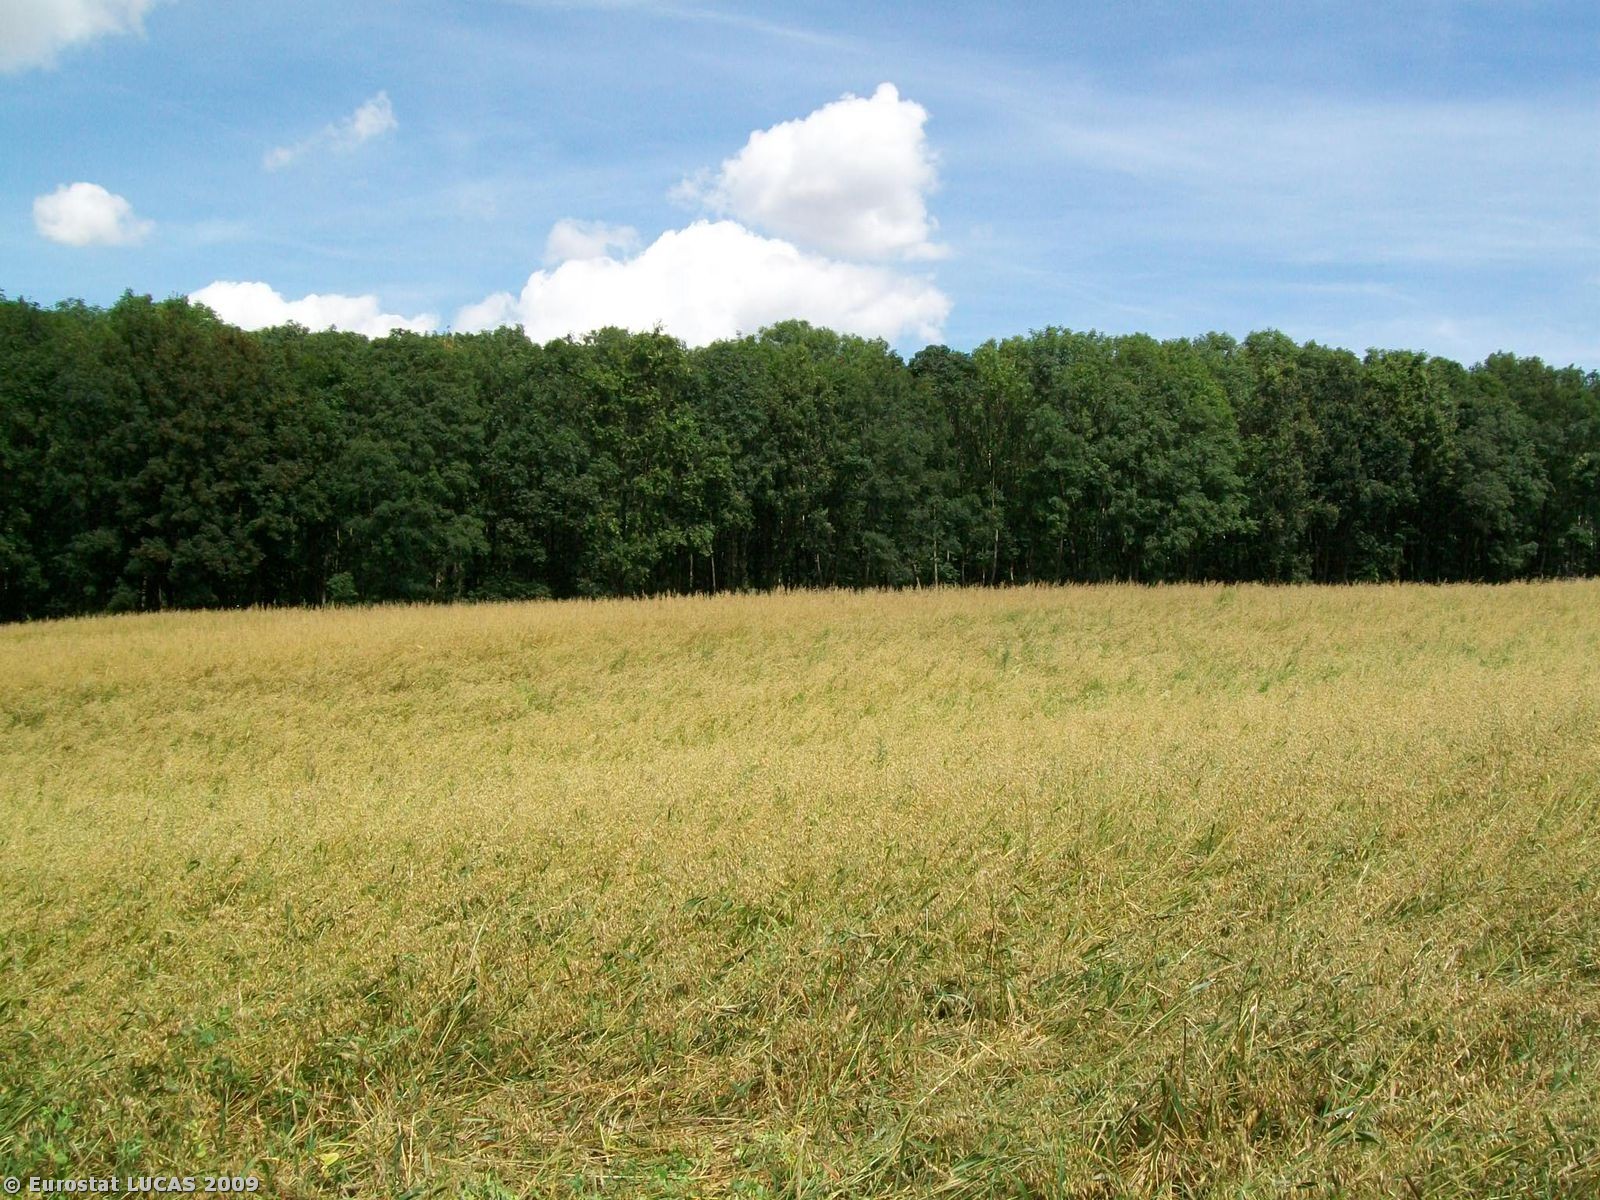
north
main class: Cropland
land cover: Oats
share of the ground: > 75 %
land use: Agriculture (excluding fallow land and kitchen gardens)
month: July
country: PL
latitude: 51.1399
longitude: 16.0806
